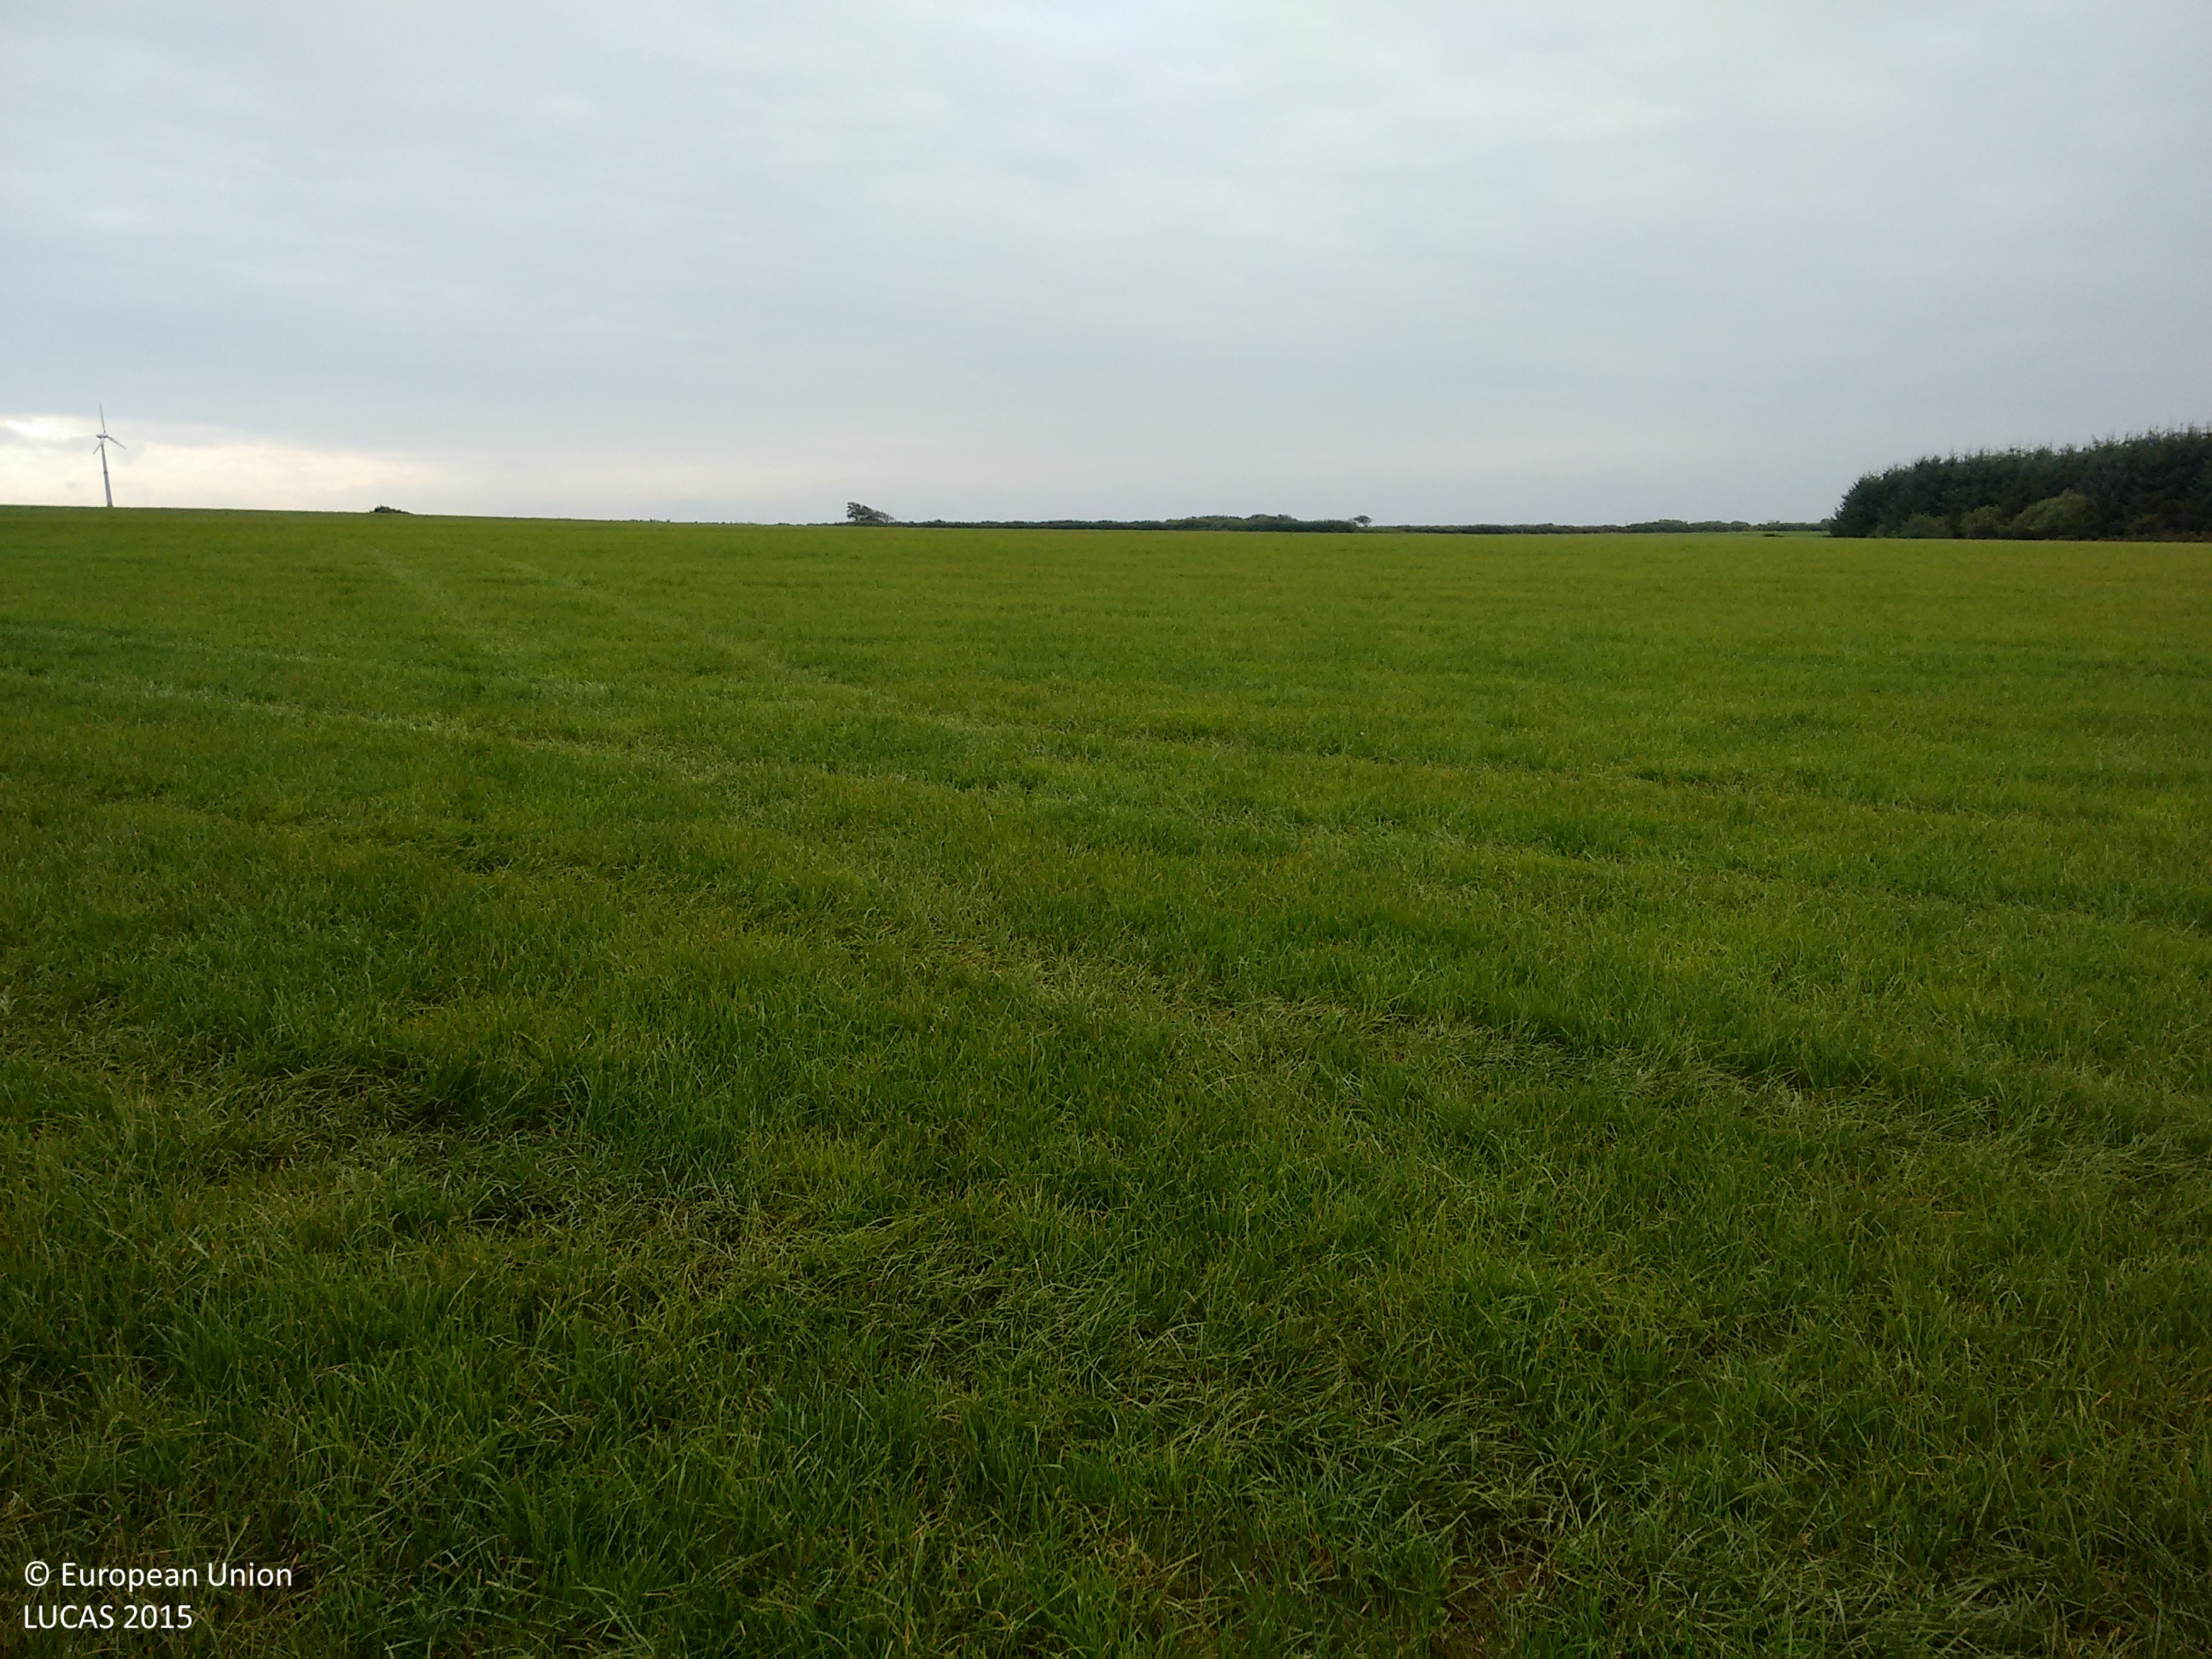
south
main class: Cropland
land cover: Temporary grasslands
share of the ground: > 75 %
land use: Agriculture (excluding fallow land and kitchen gardens)
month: September
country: GB
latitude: 50.9195
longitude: -4.4570
